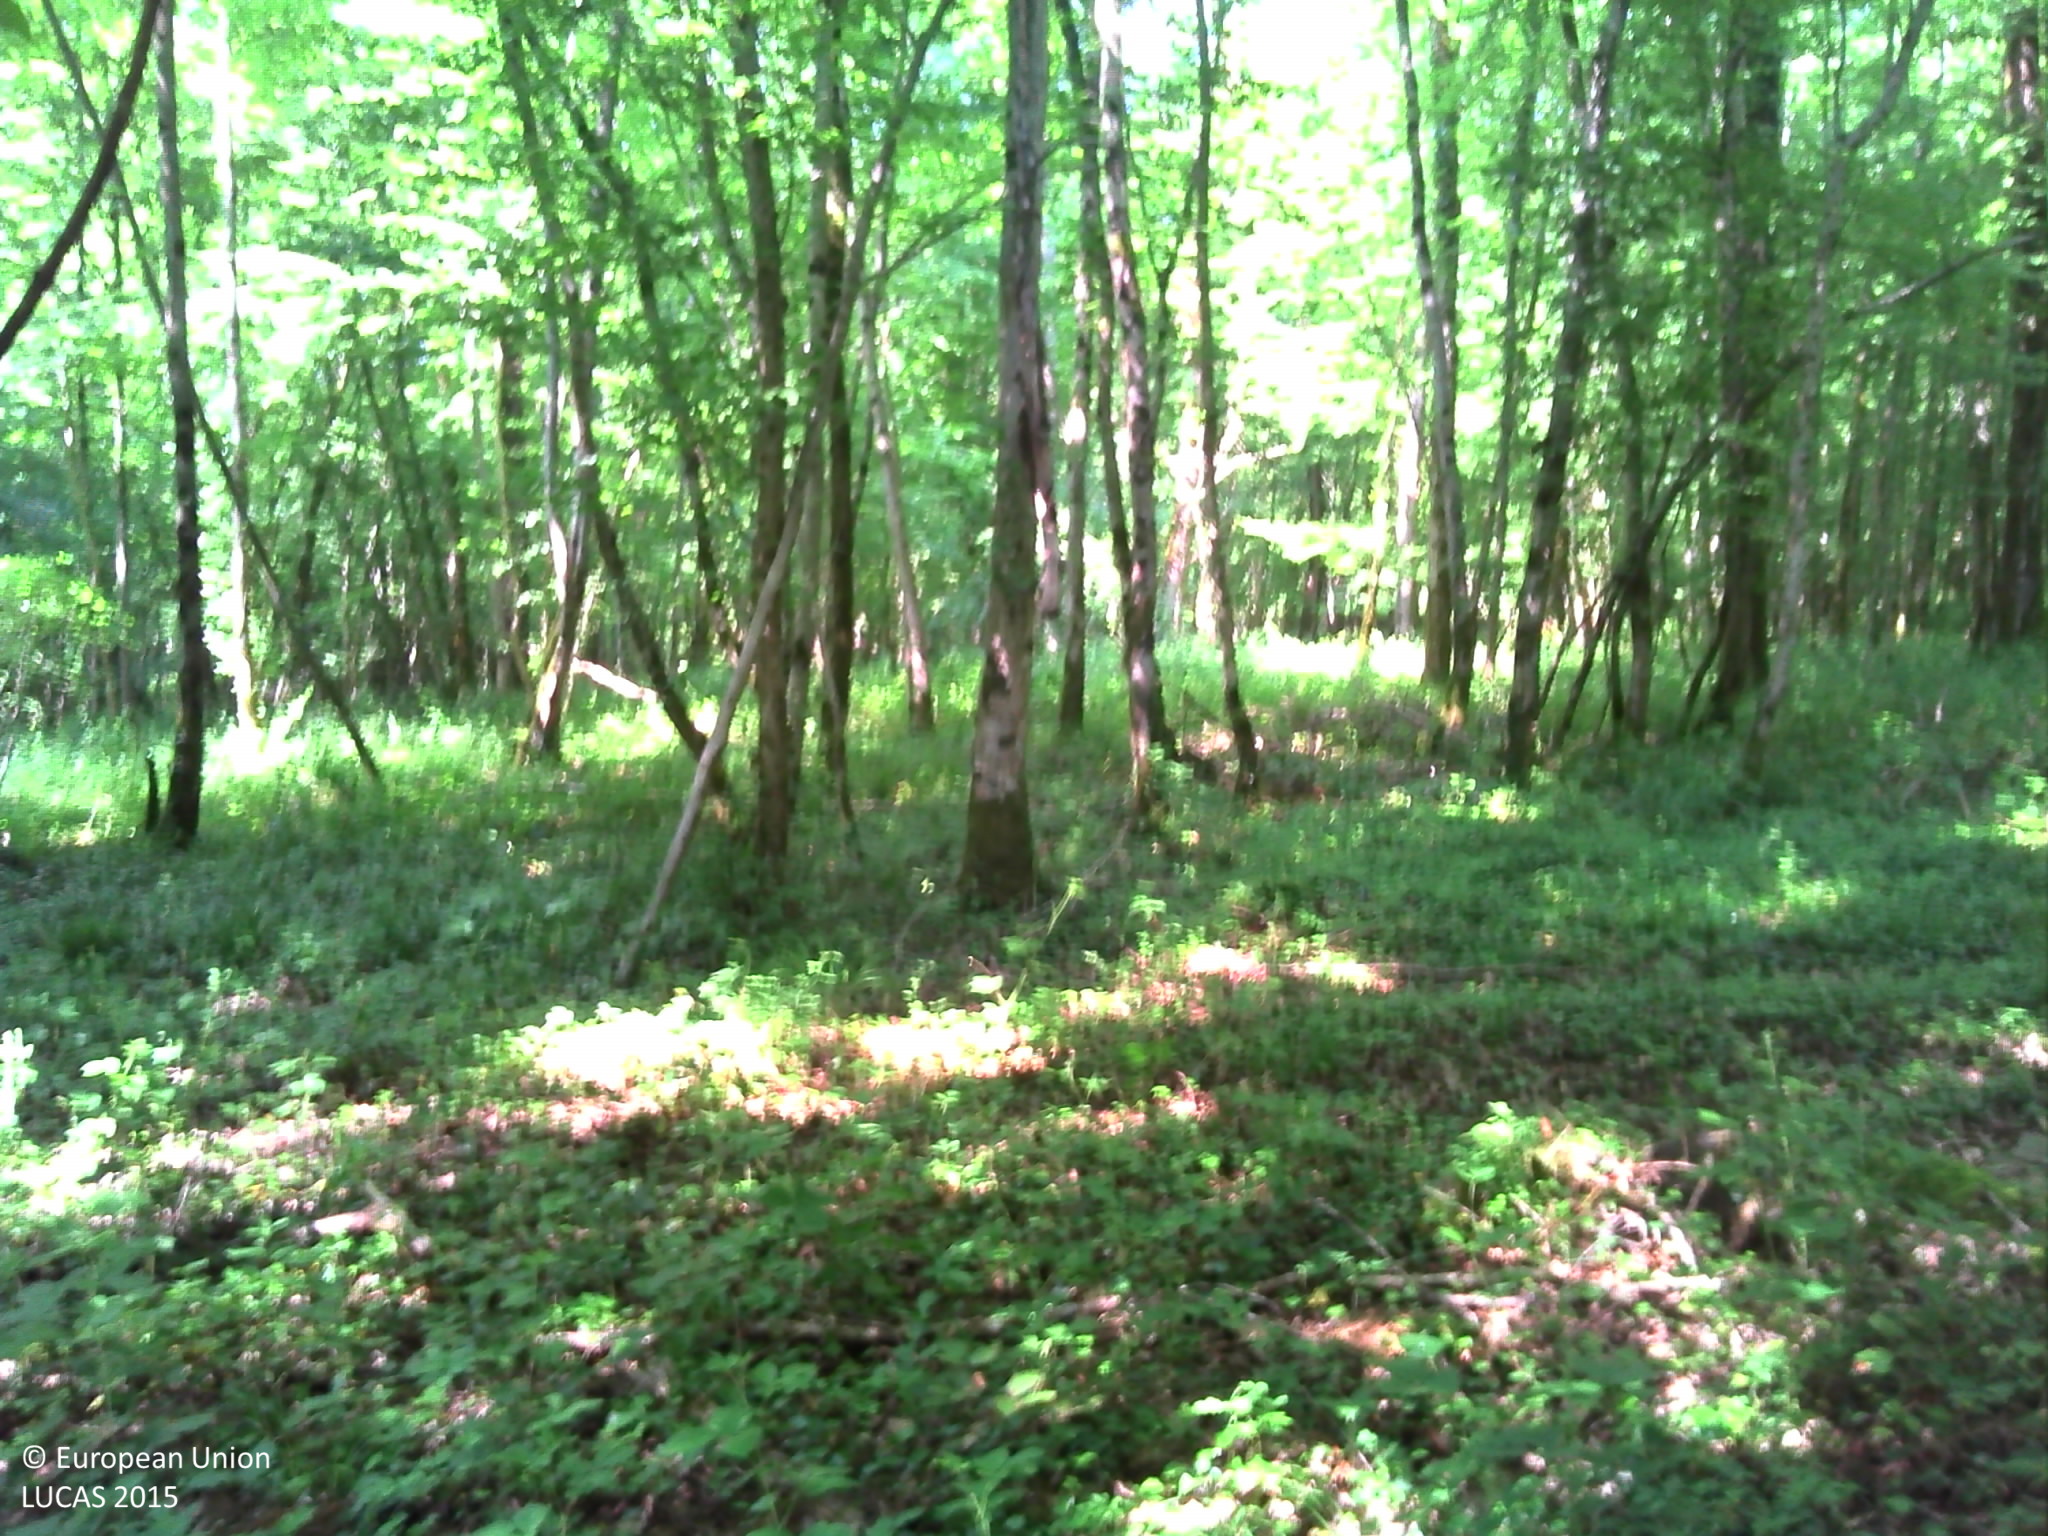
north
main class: Woodland
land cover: Broadleaved woodland
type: beech forest
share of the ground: > 75 %
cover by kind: broadleaved forest trees 95 %, herbaceous plants 5 %
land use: Forestry
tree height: > 5 m
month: June
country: FR
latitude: 47.5667
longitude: 6.2930
